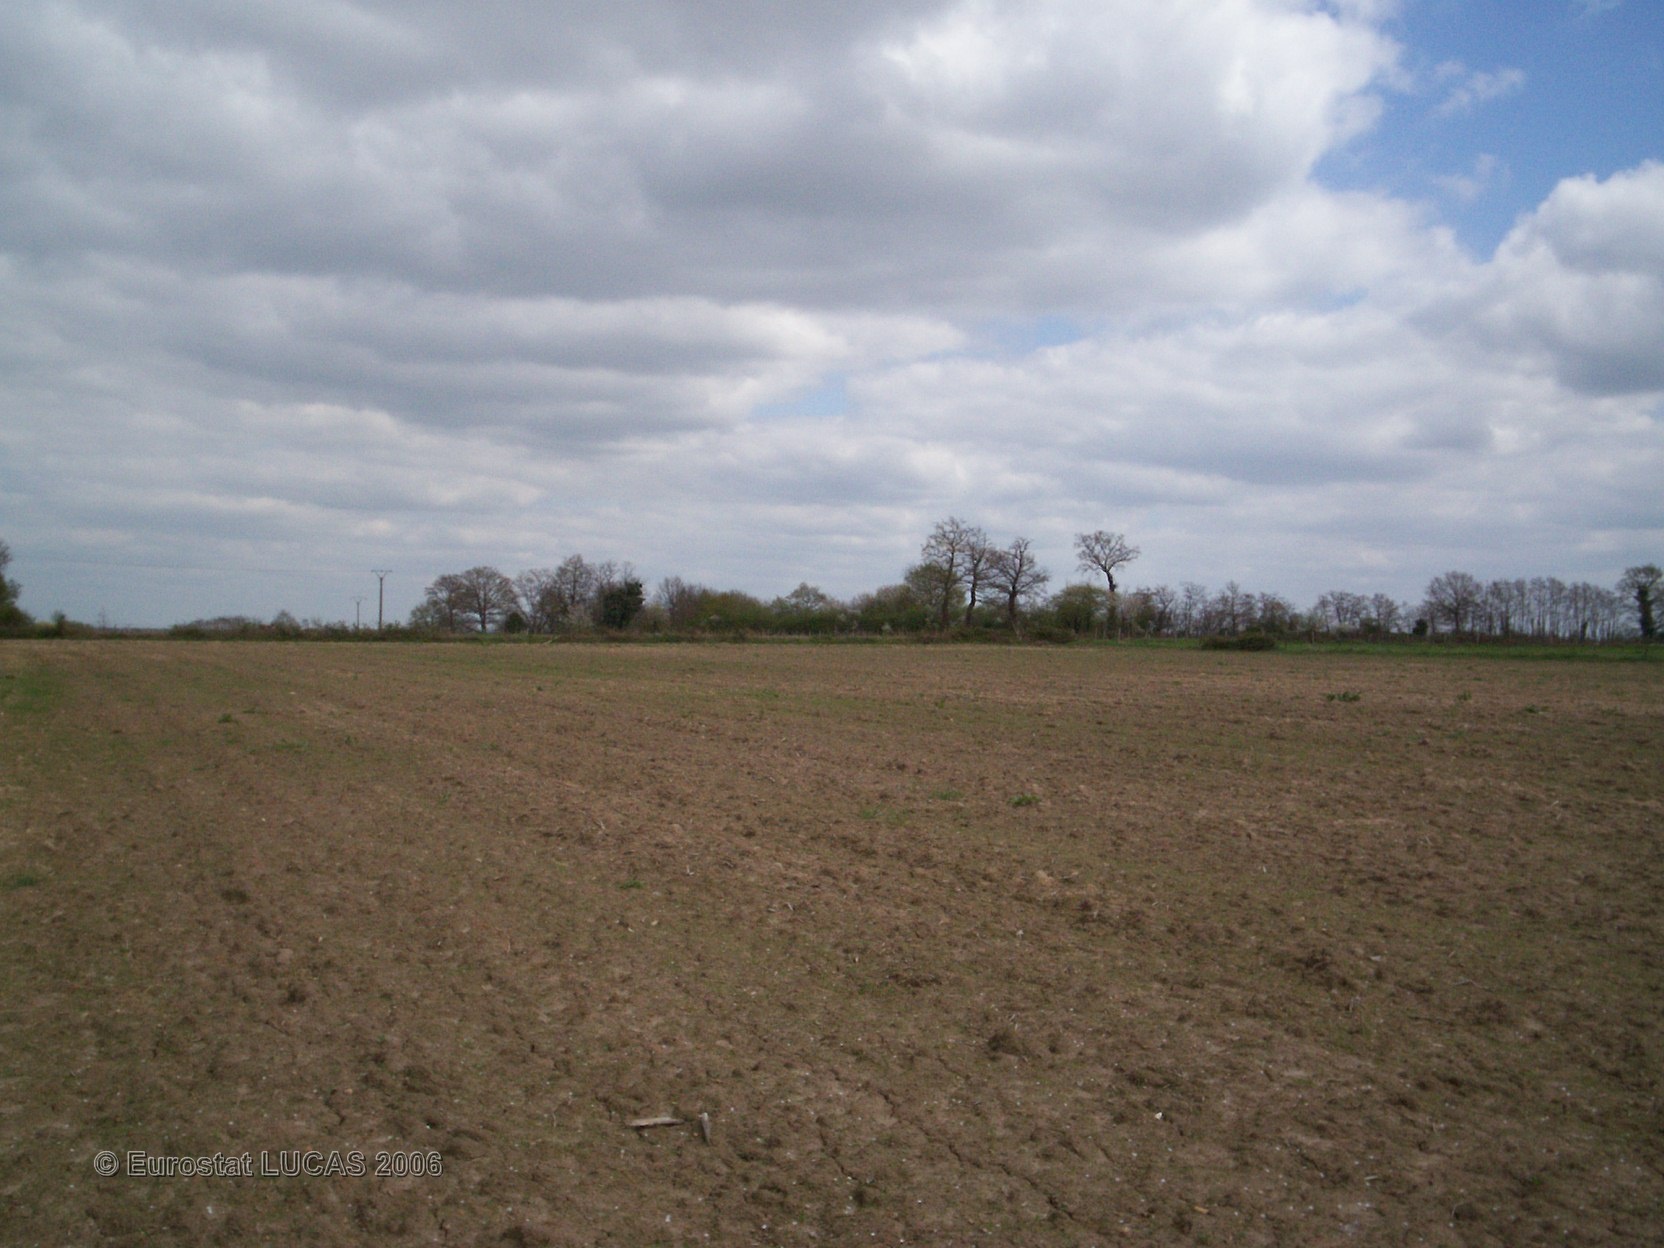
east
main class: Grassland
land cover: Grassland without tree/shrub cover
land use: Agriculture (excluding fallow land and kitchen gardens)
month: April
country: FR
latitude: 46.1849
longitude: 0.5396
